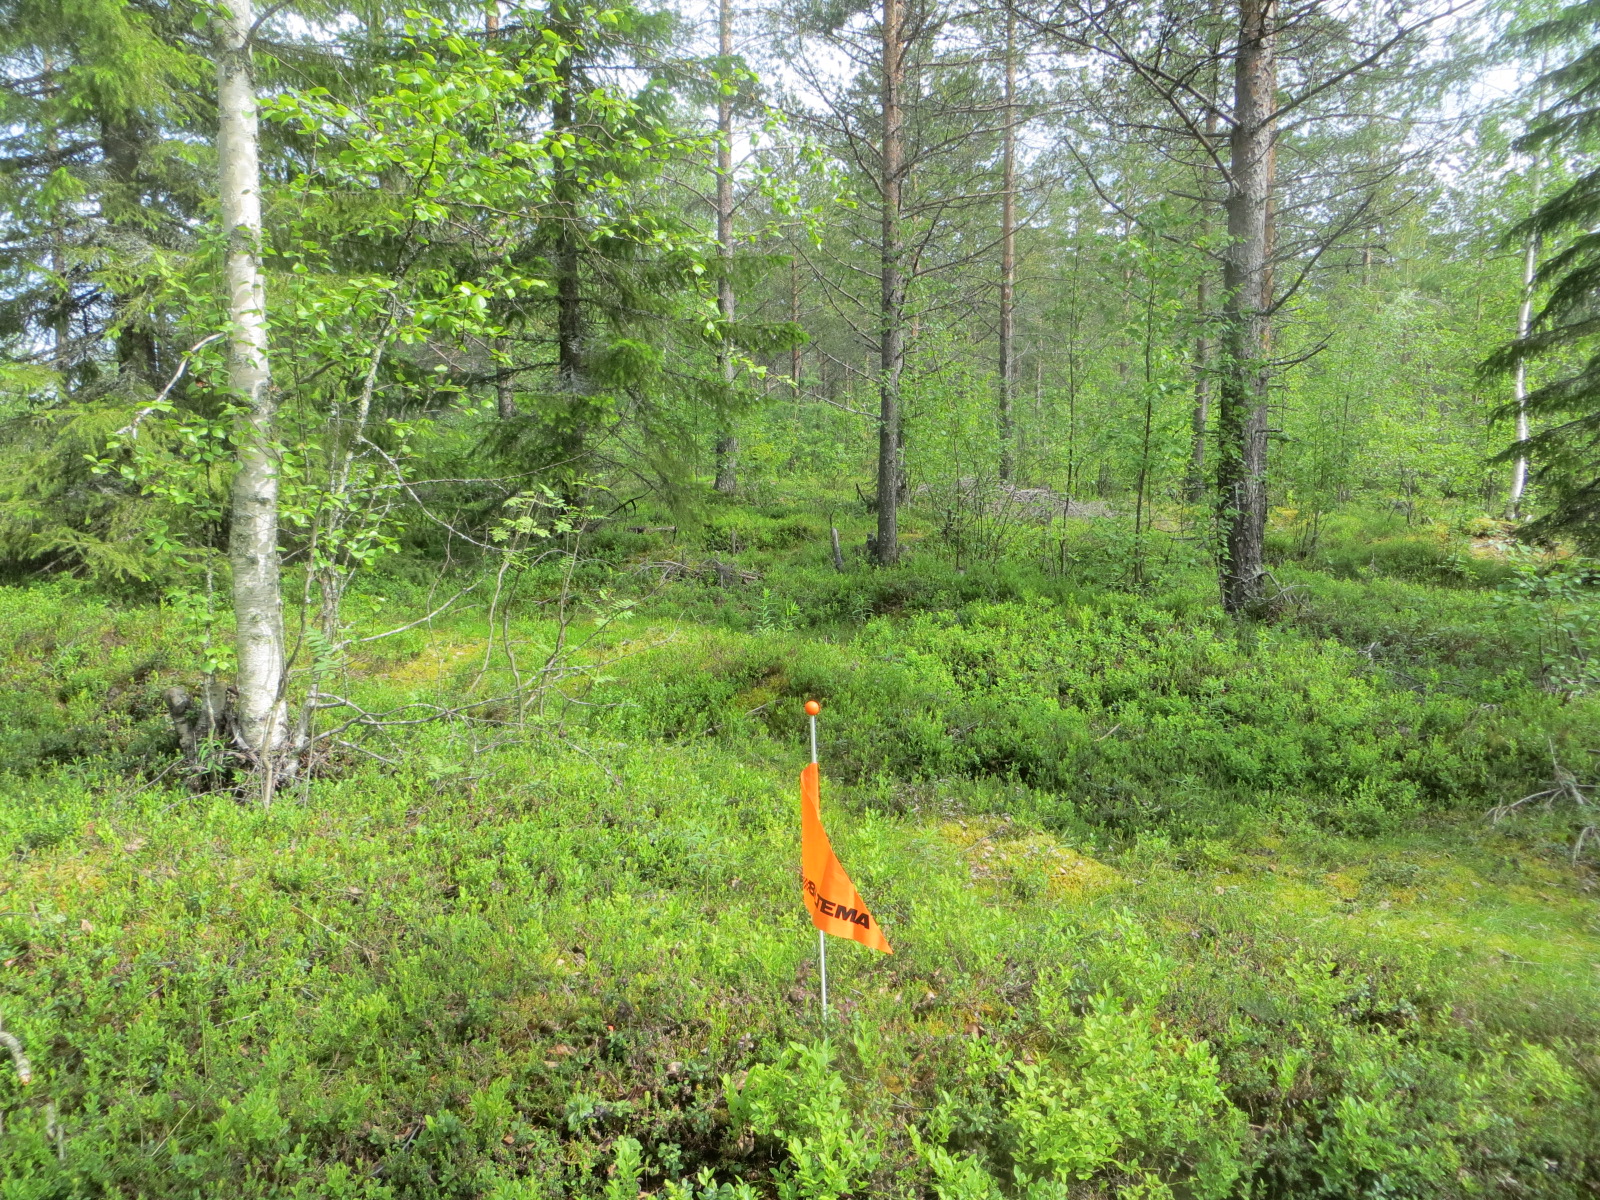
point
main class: Woodland
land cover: Pine dominated mixed woodland
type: boreal forest
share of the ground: 50 - 75 %
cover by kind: coniferous forest trees 40 %, broadleaved forest trees 30 %, shrubs 30 %
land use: Forestry
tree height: > 5 m
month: June
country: FI
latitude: 66.0023
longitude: 26.4204
